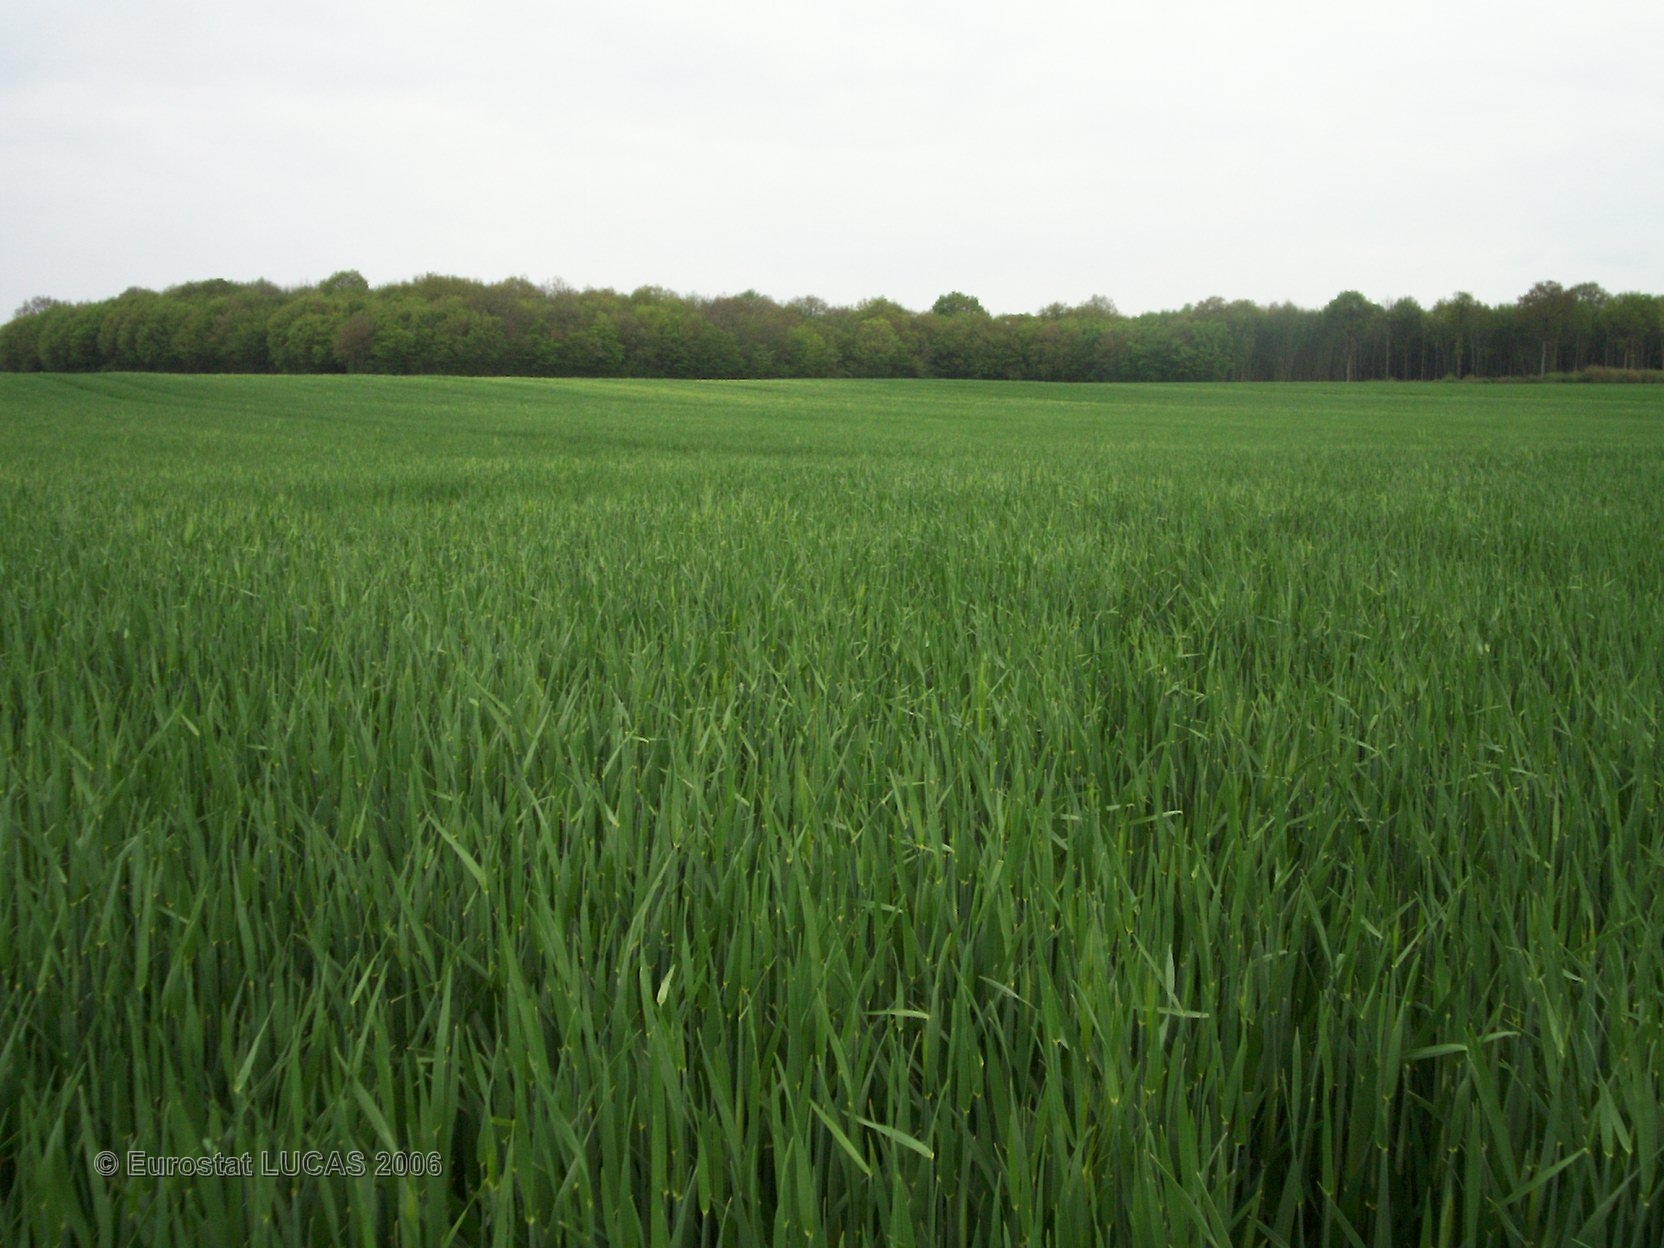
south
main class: Cropland
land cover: Barley
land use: Agriculture (excluding fallow land and kitchen gardens)
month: April
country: FR
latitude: 46.9032
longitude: 1.5475
